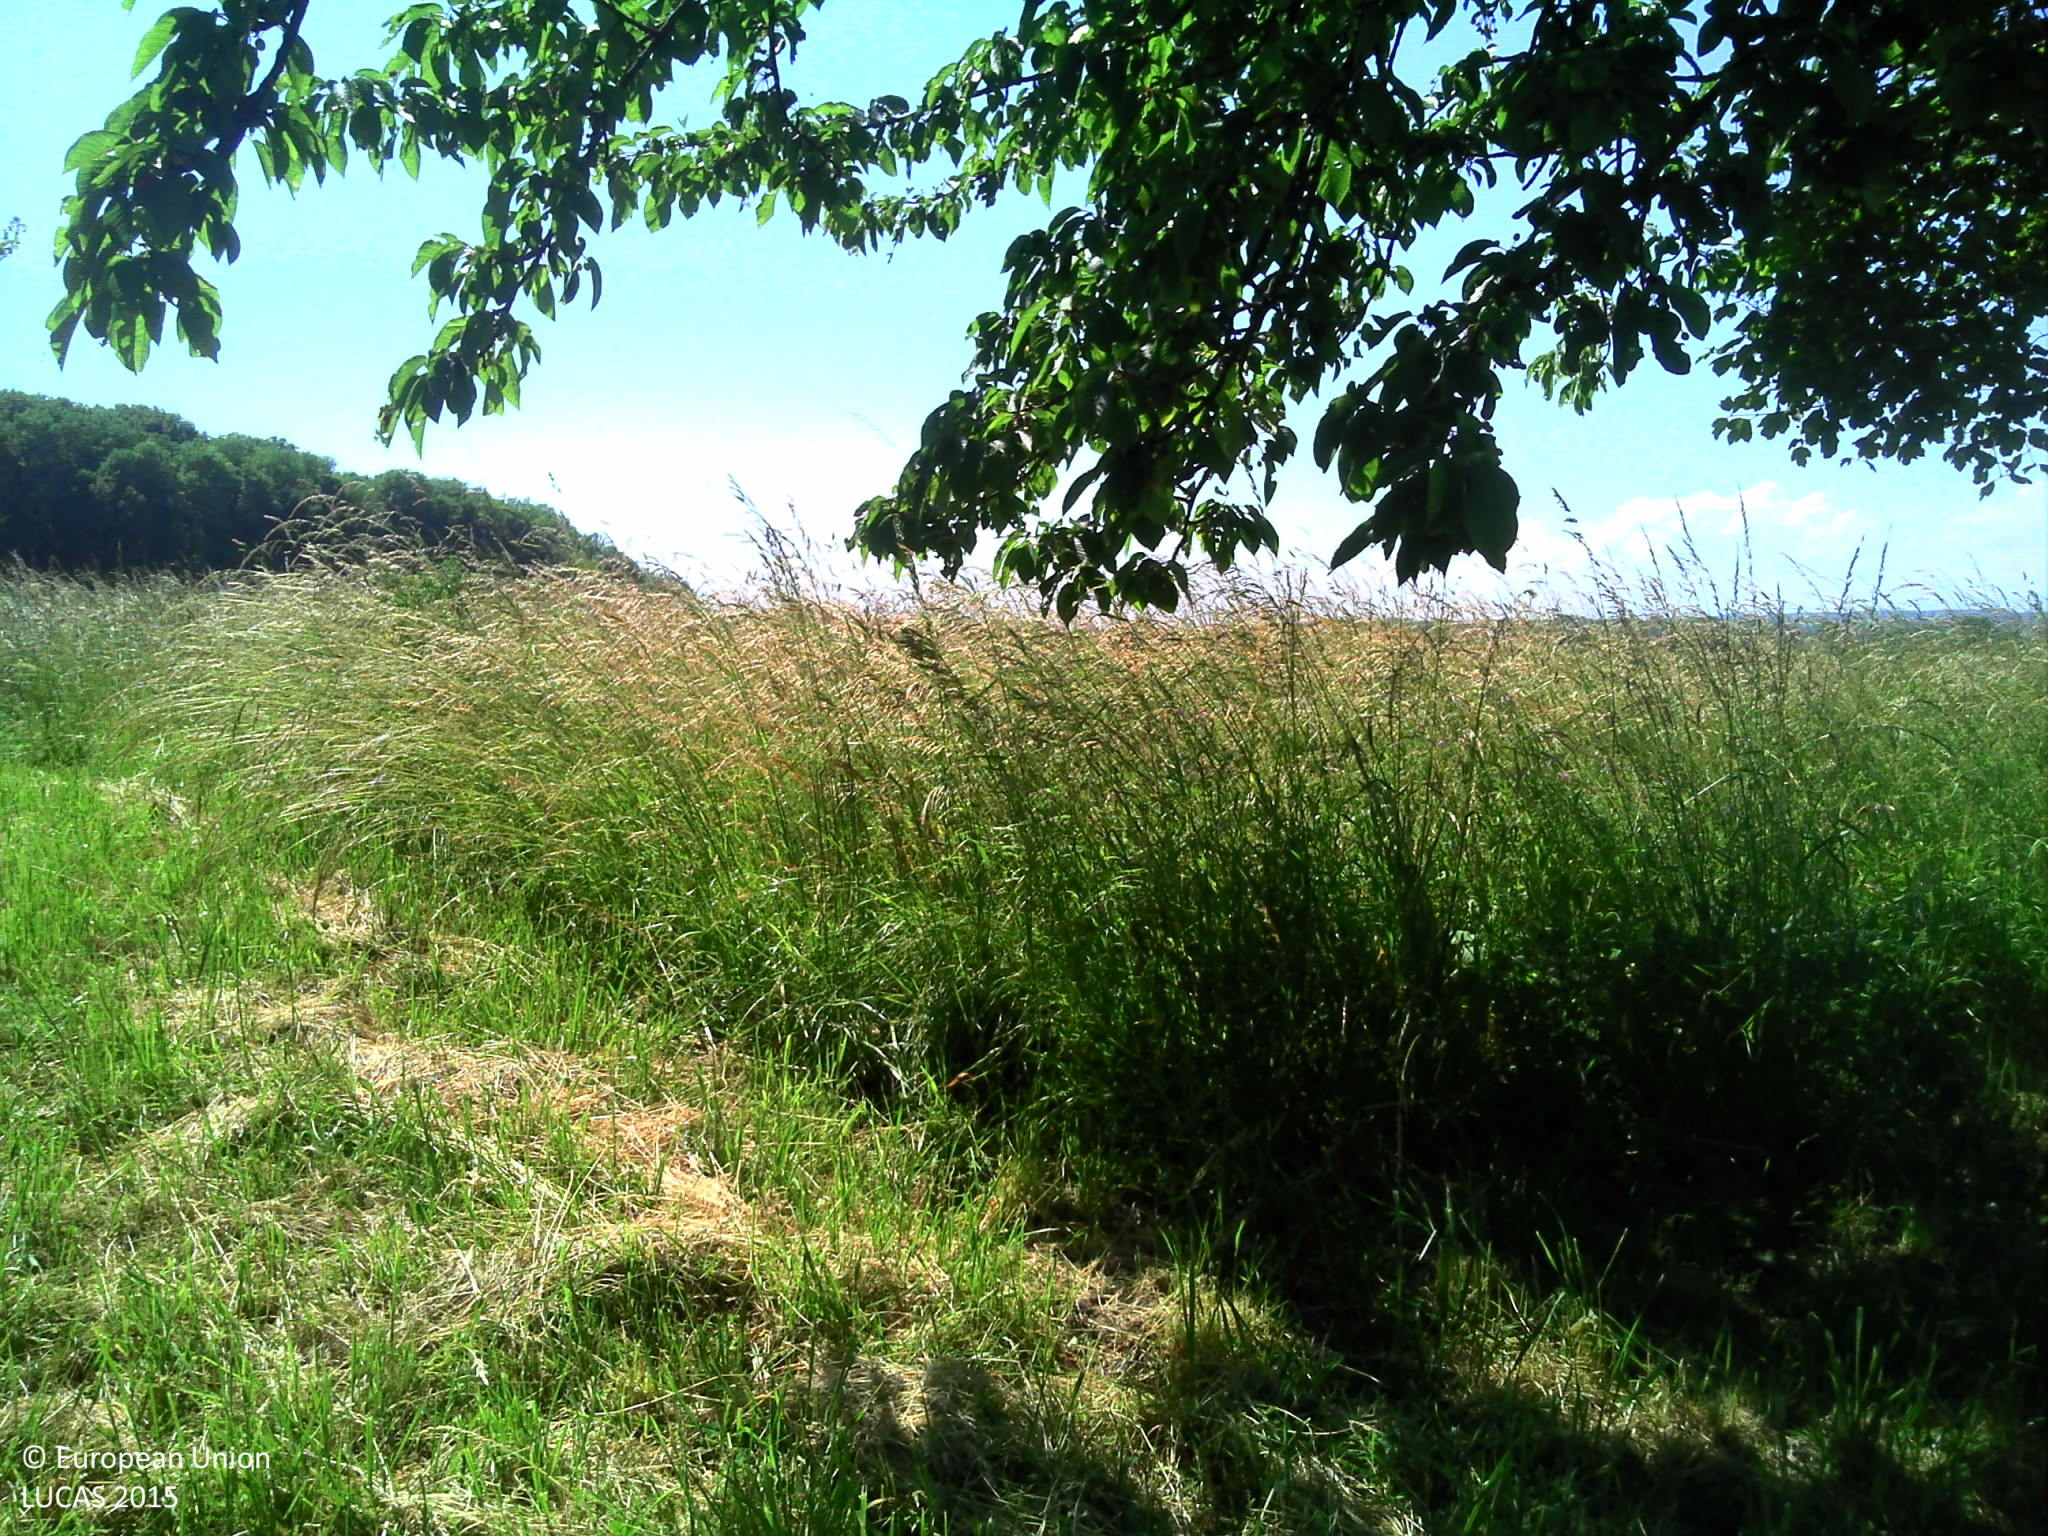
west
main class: Cropland
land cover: Cherry fruit
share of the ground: > 75 %
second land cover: Grassland without tree/shrub cover
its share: > 75 %
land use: Agriculture (excluding fallow land and kitchen gardens)
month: June
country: FR
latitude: 47.6349
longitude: 7.4063
